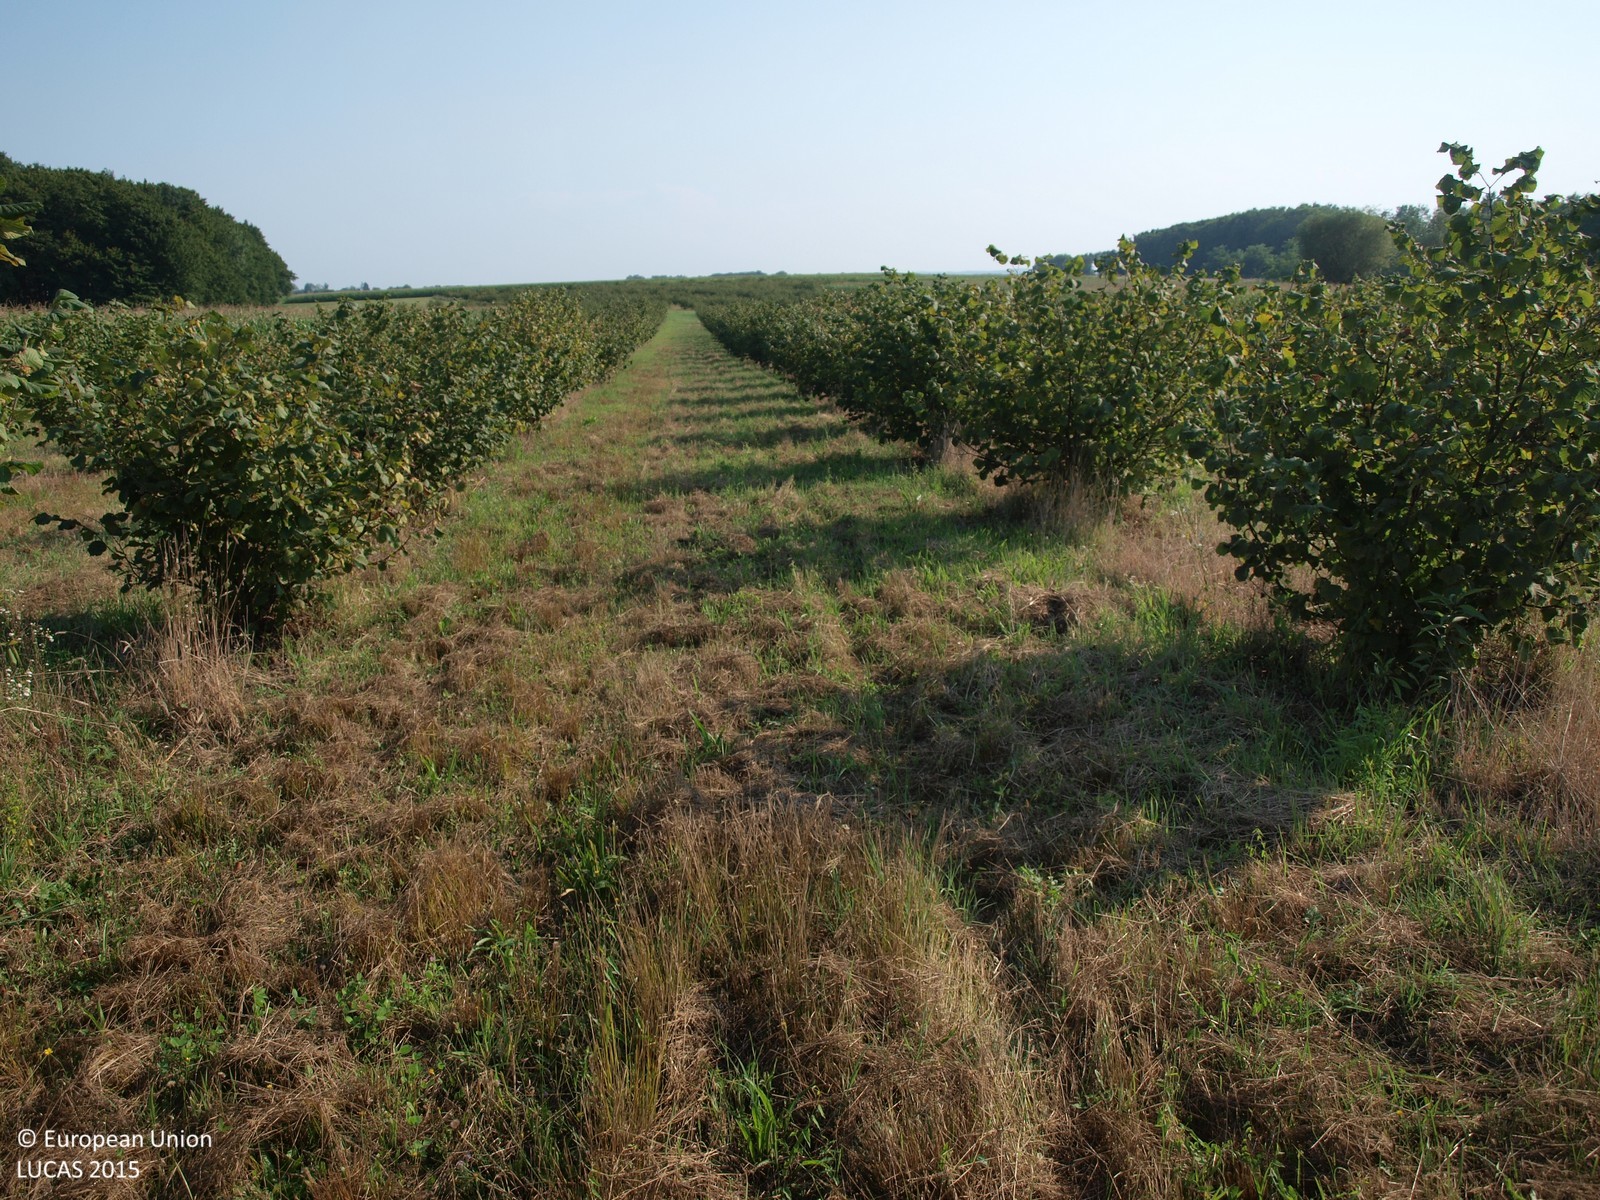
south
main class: Cropland
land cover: Nuts trees
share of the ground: 25 - 50 %
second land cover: Grassland without tree/shrub cover
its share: > 75 %
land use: Agriculture (excluding fallow land and kitchen gardens)
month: August
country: HR
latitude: 45.8414
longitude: 16.5789
